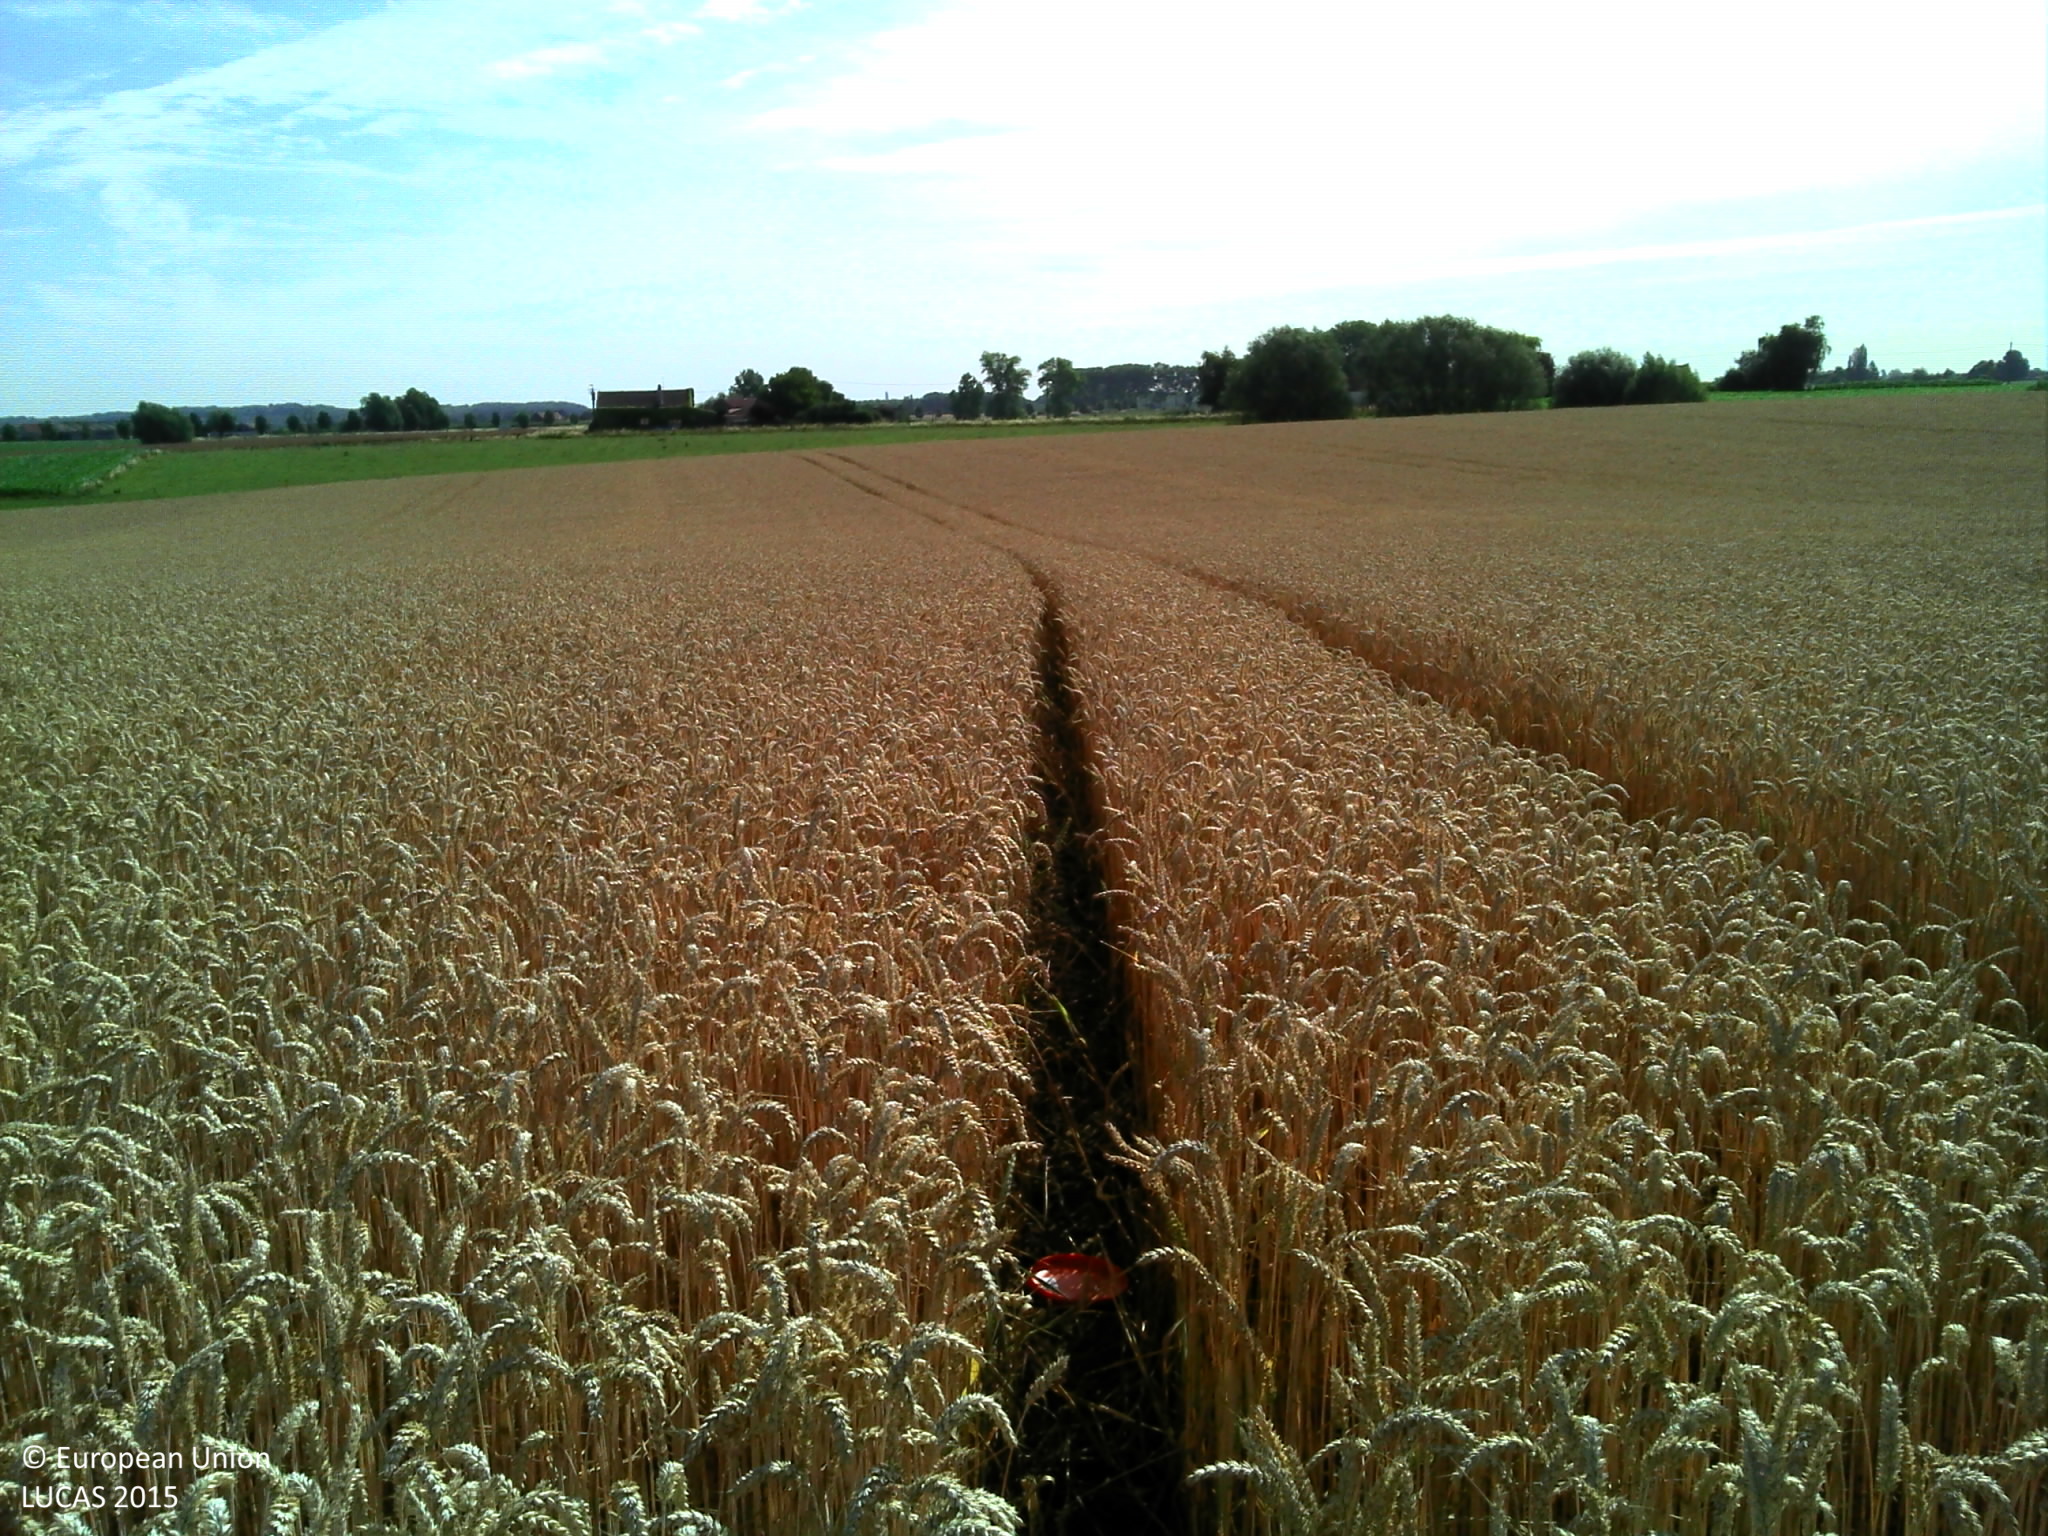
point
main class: Cropland
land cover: Common wheat
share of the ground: > 75 %
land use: Agriculture (excluding fallow land and kitchen gardens)
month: July
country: BE
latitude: 50.5727
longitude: 4.1065
